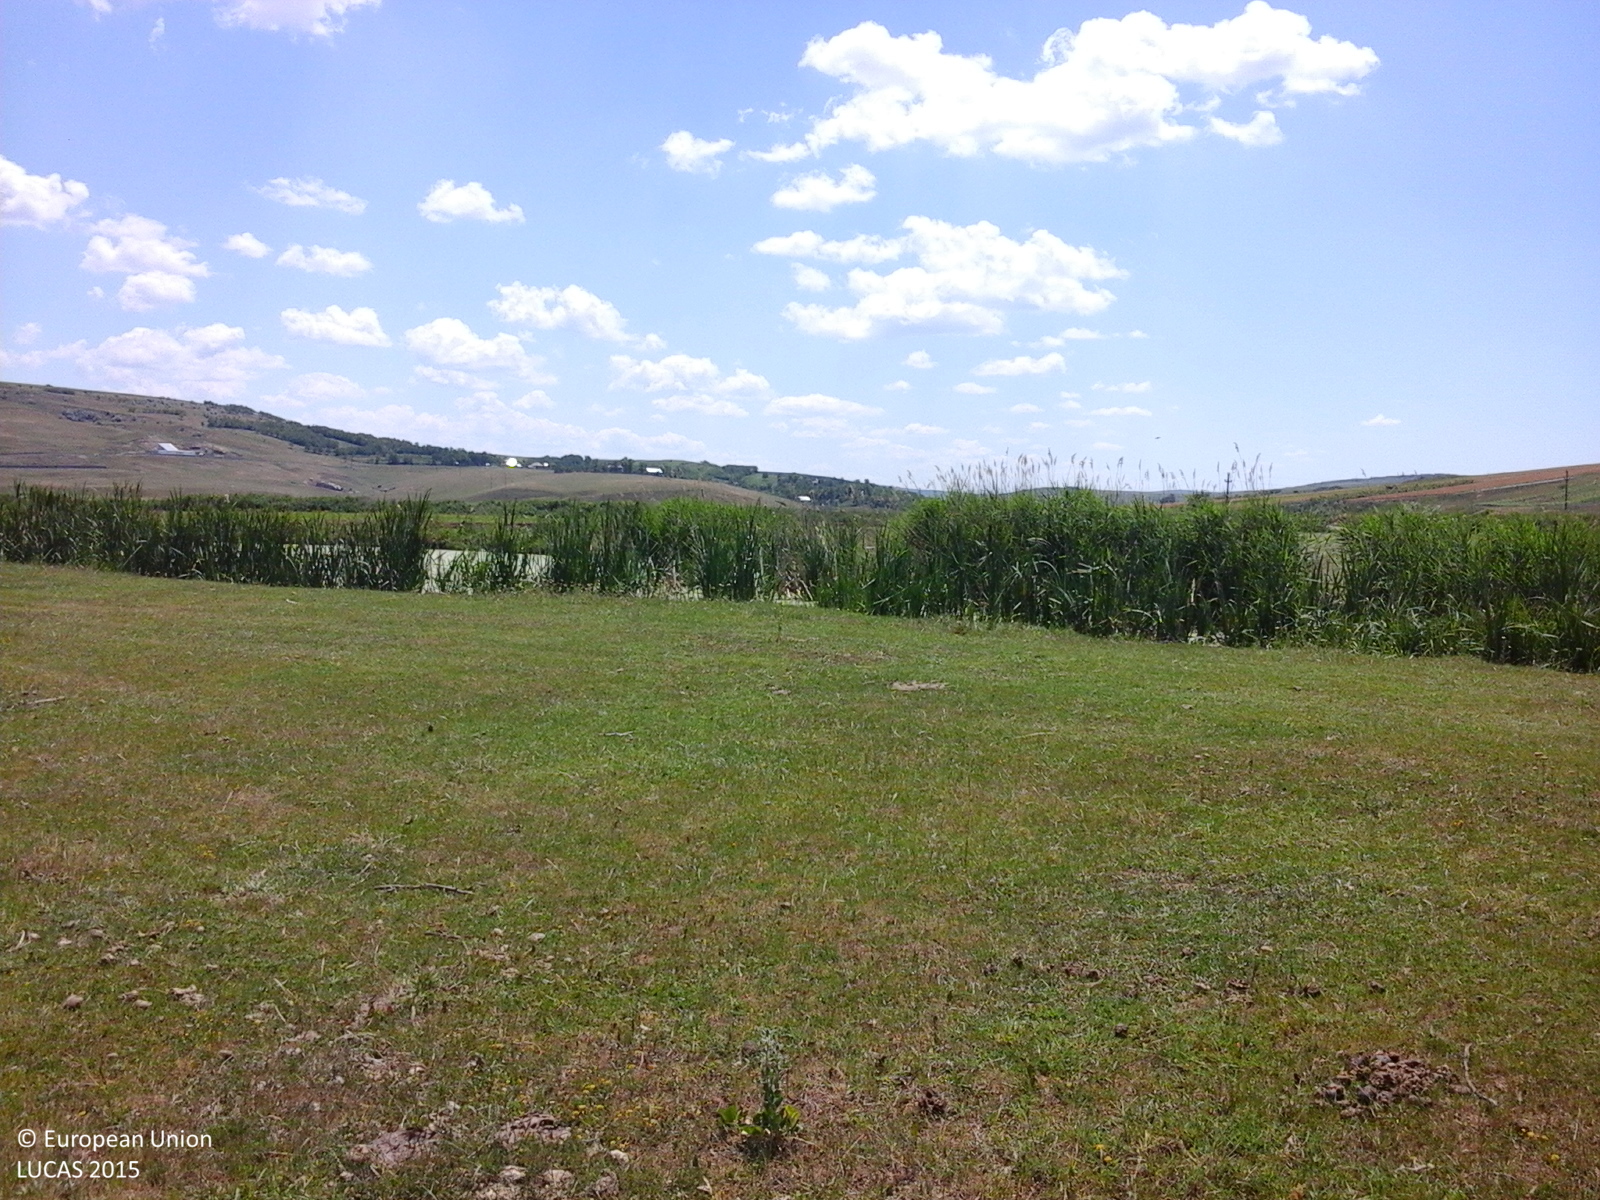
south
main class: Grassland
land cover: Grassland without tree/shrub cover
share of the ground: > 75 %
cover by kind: herbaceous plants 100 %
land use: Agriculture (excluding fallow land and kitchen gardens)
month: June
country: RO
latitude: 47.2142
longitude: 27.0430
